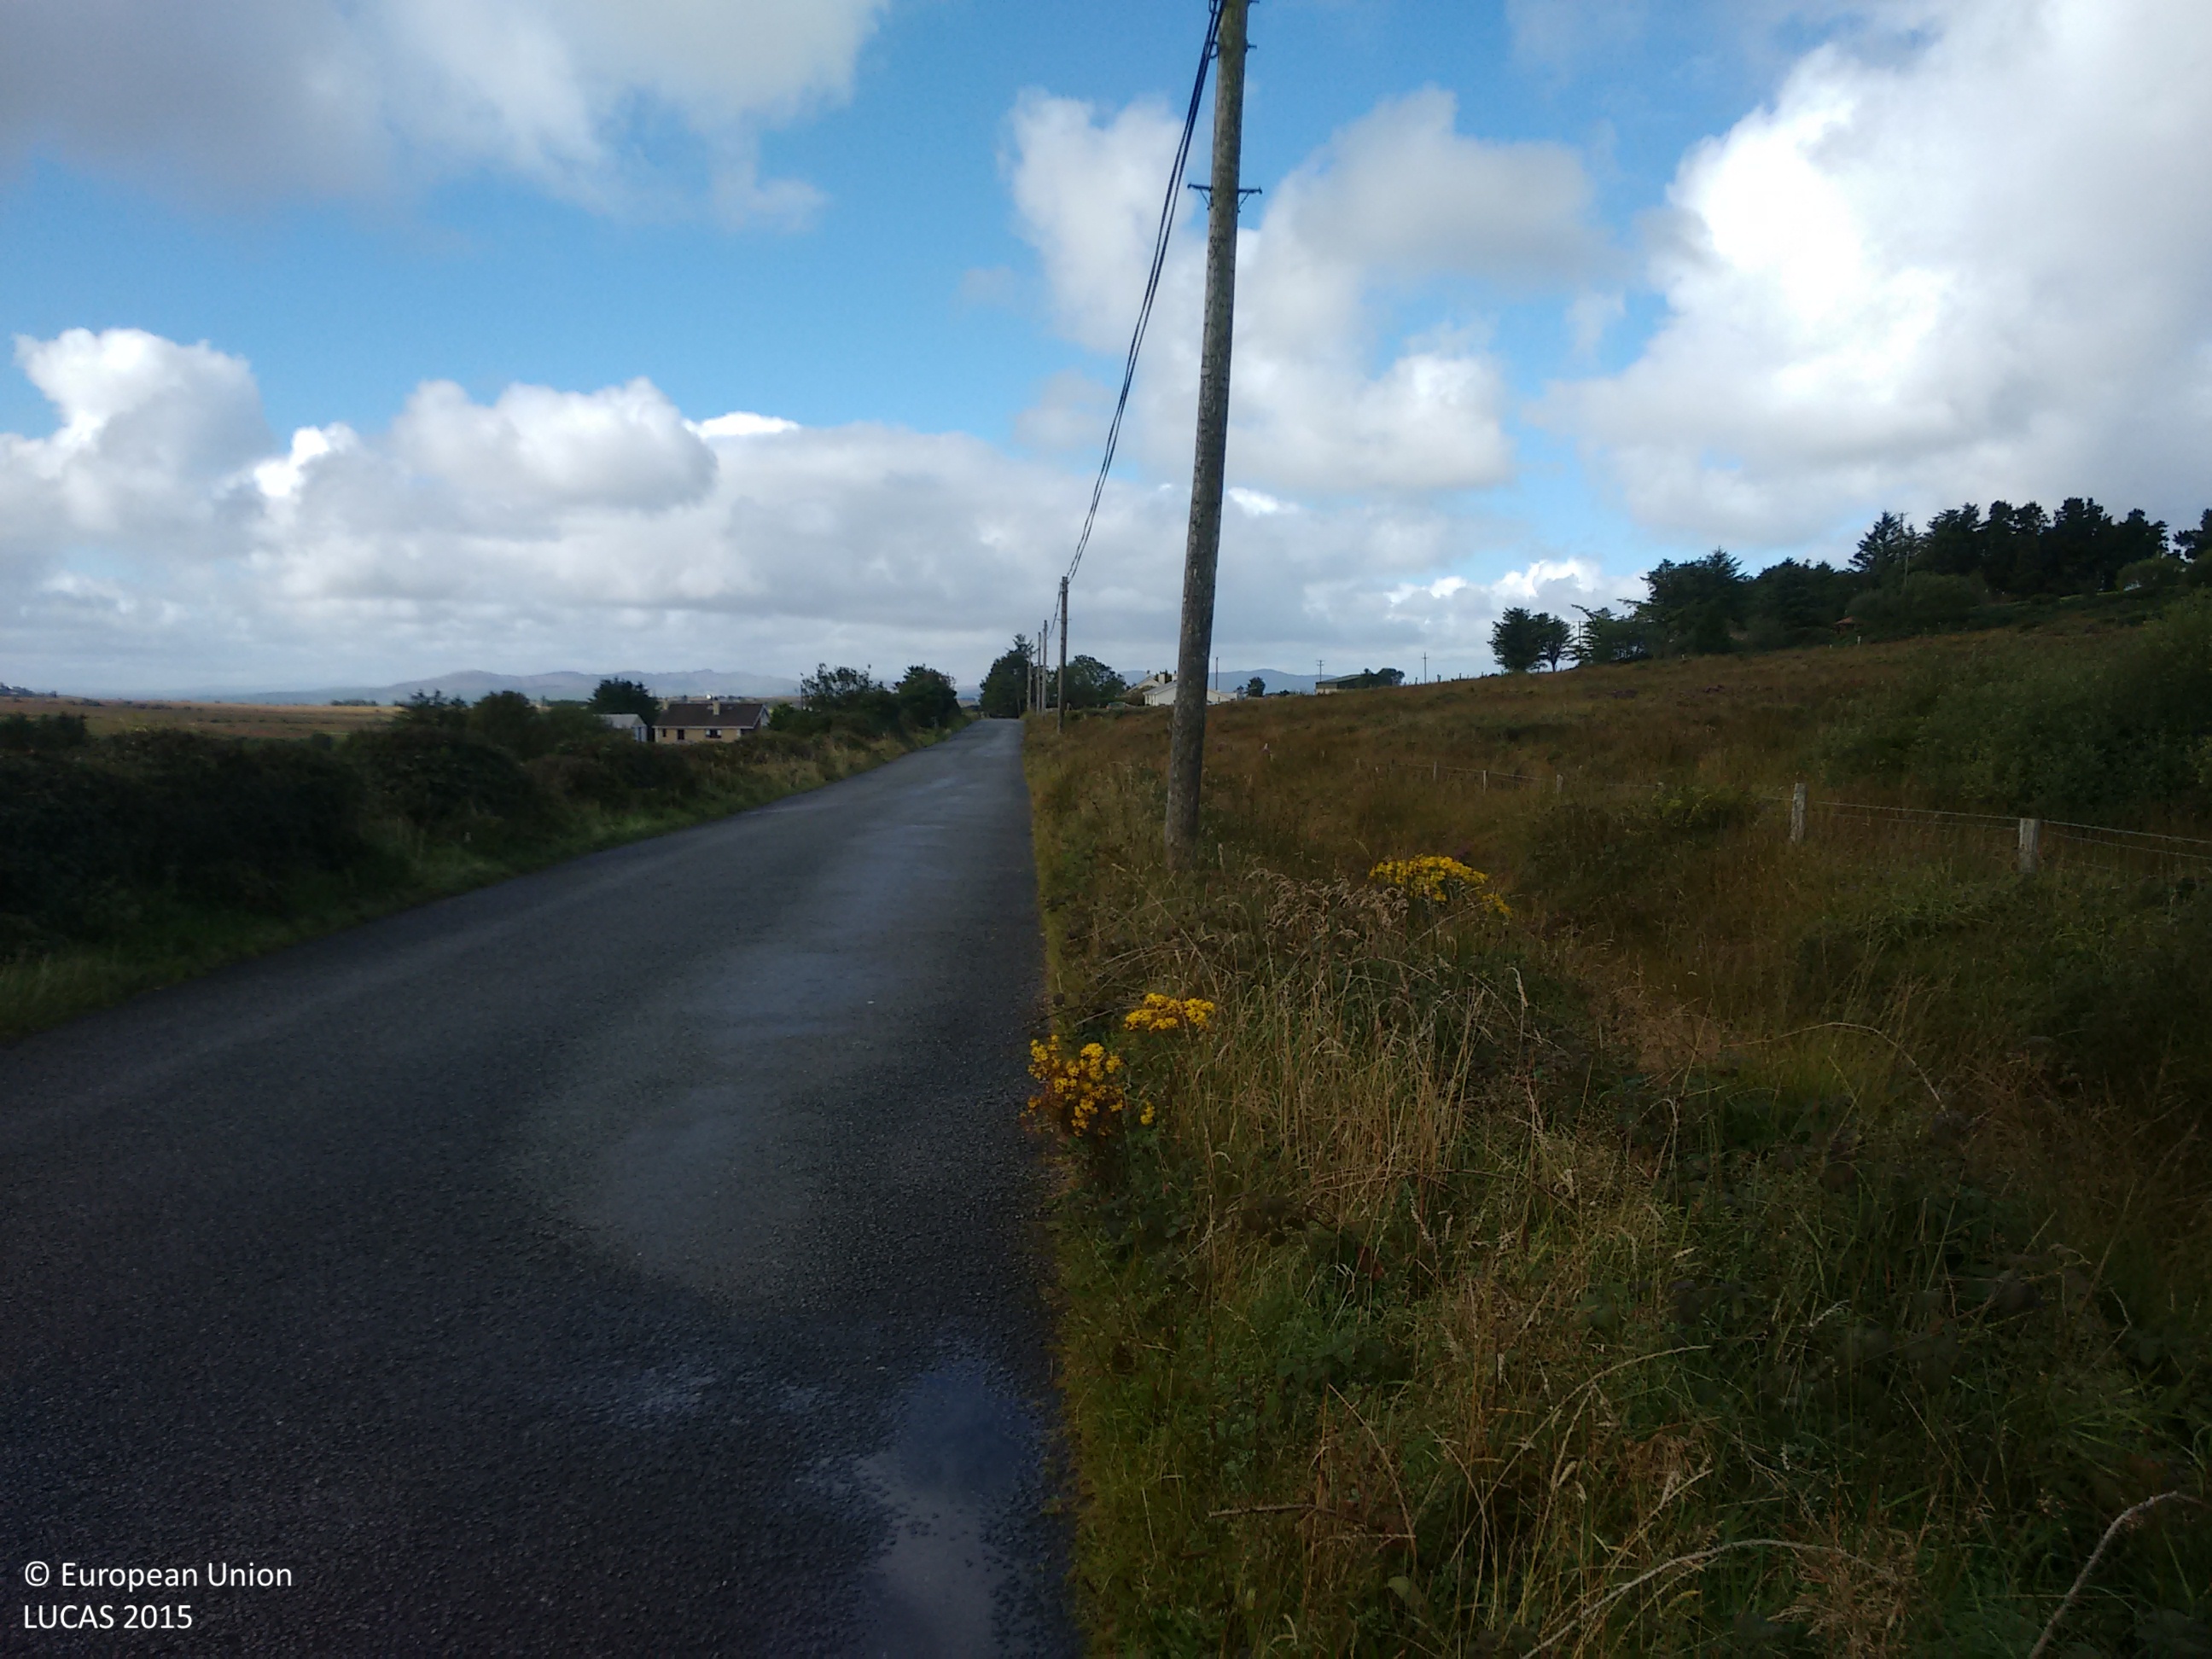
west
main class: Shrubland
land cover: Shrubland without tree cover
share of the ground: > 75 %
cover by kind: shrubs 90 %, herbaceous plants 10 %
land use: Fallow land
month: September
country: IE
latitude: 55.1555
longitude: -7.3651
